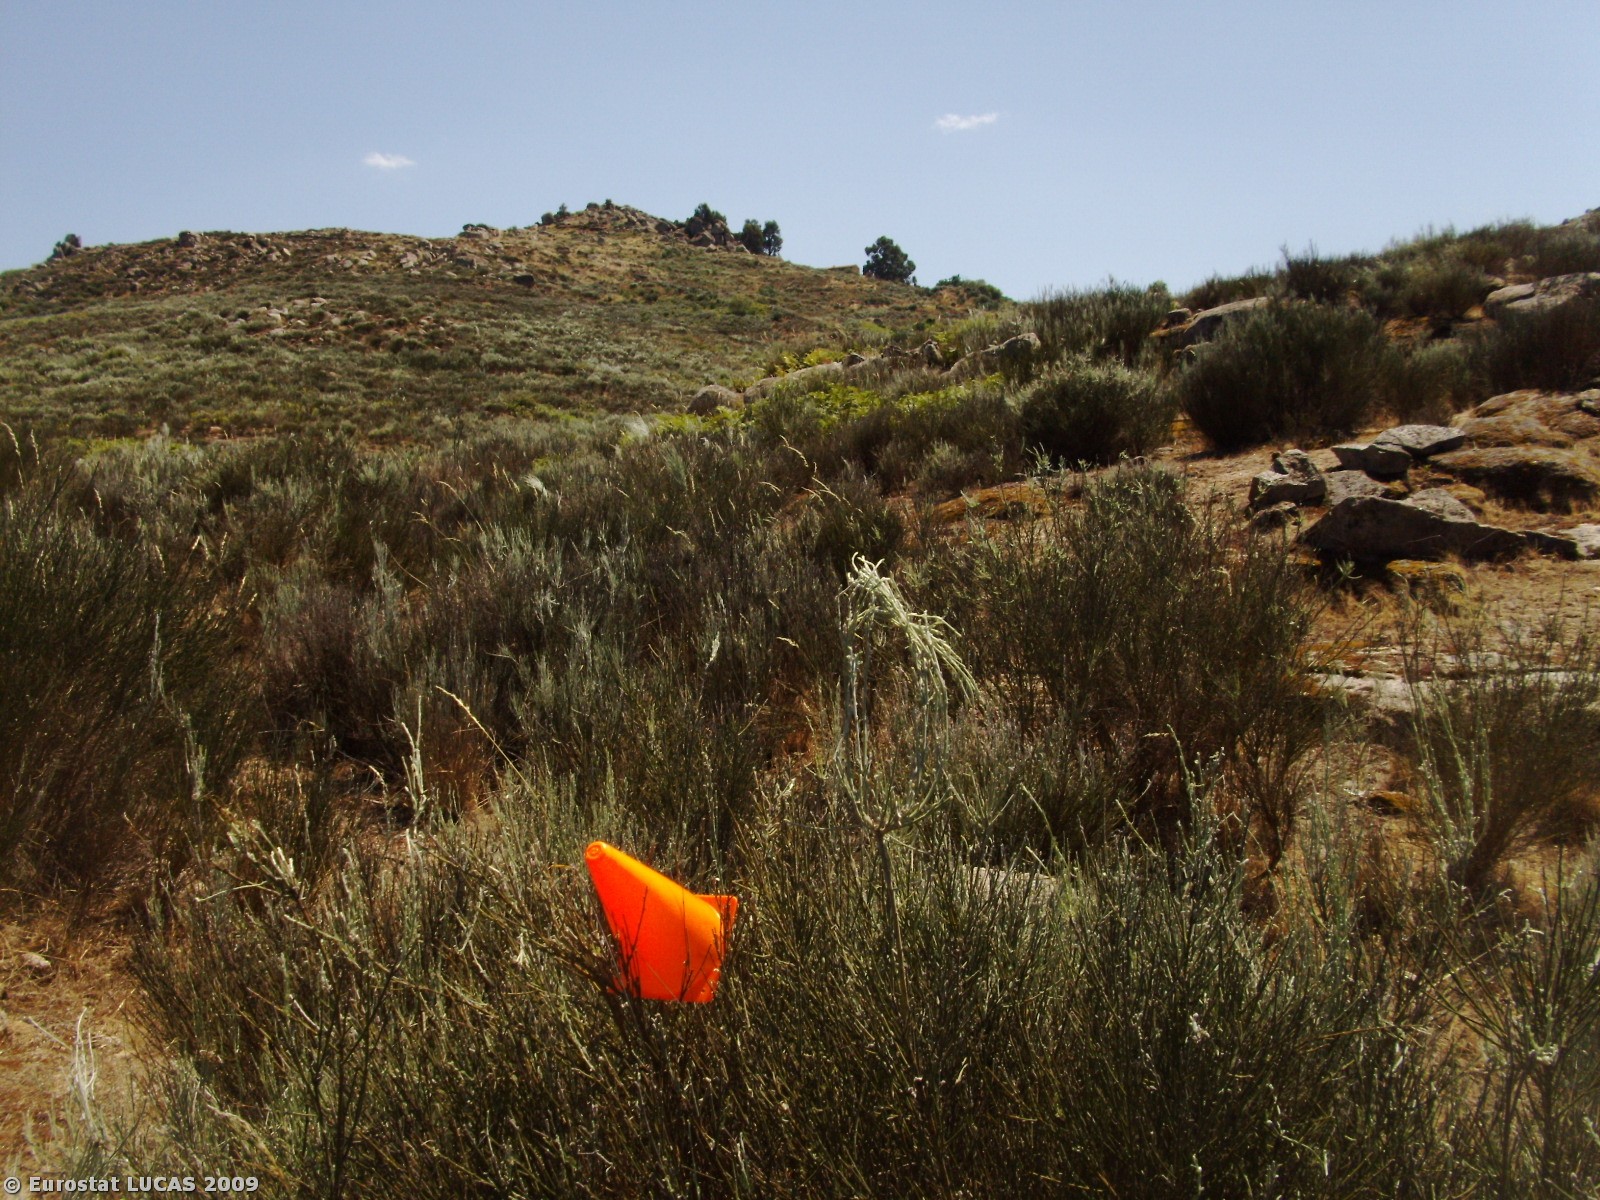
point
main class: Shrubland
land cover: Shrubland without tree cover
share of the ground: > 75 %
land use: Unused
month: July
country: PT
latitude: 40.3878
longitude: -7.2429
